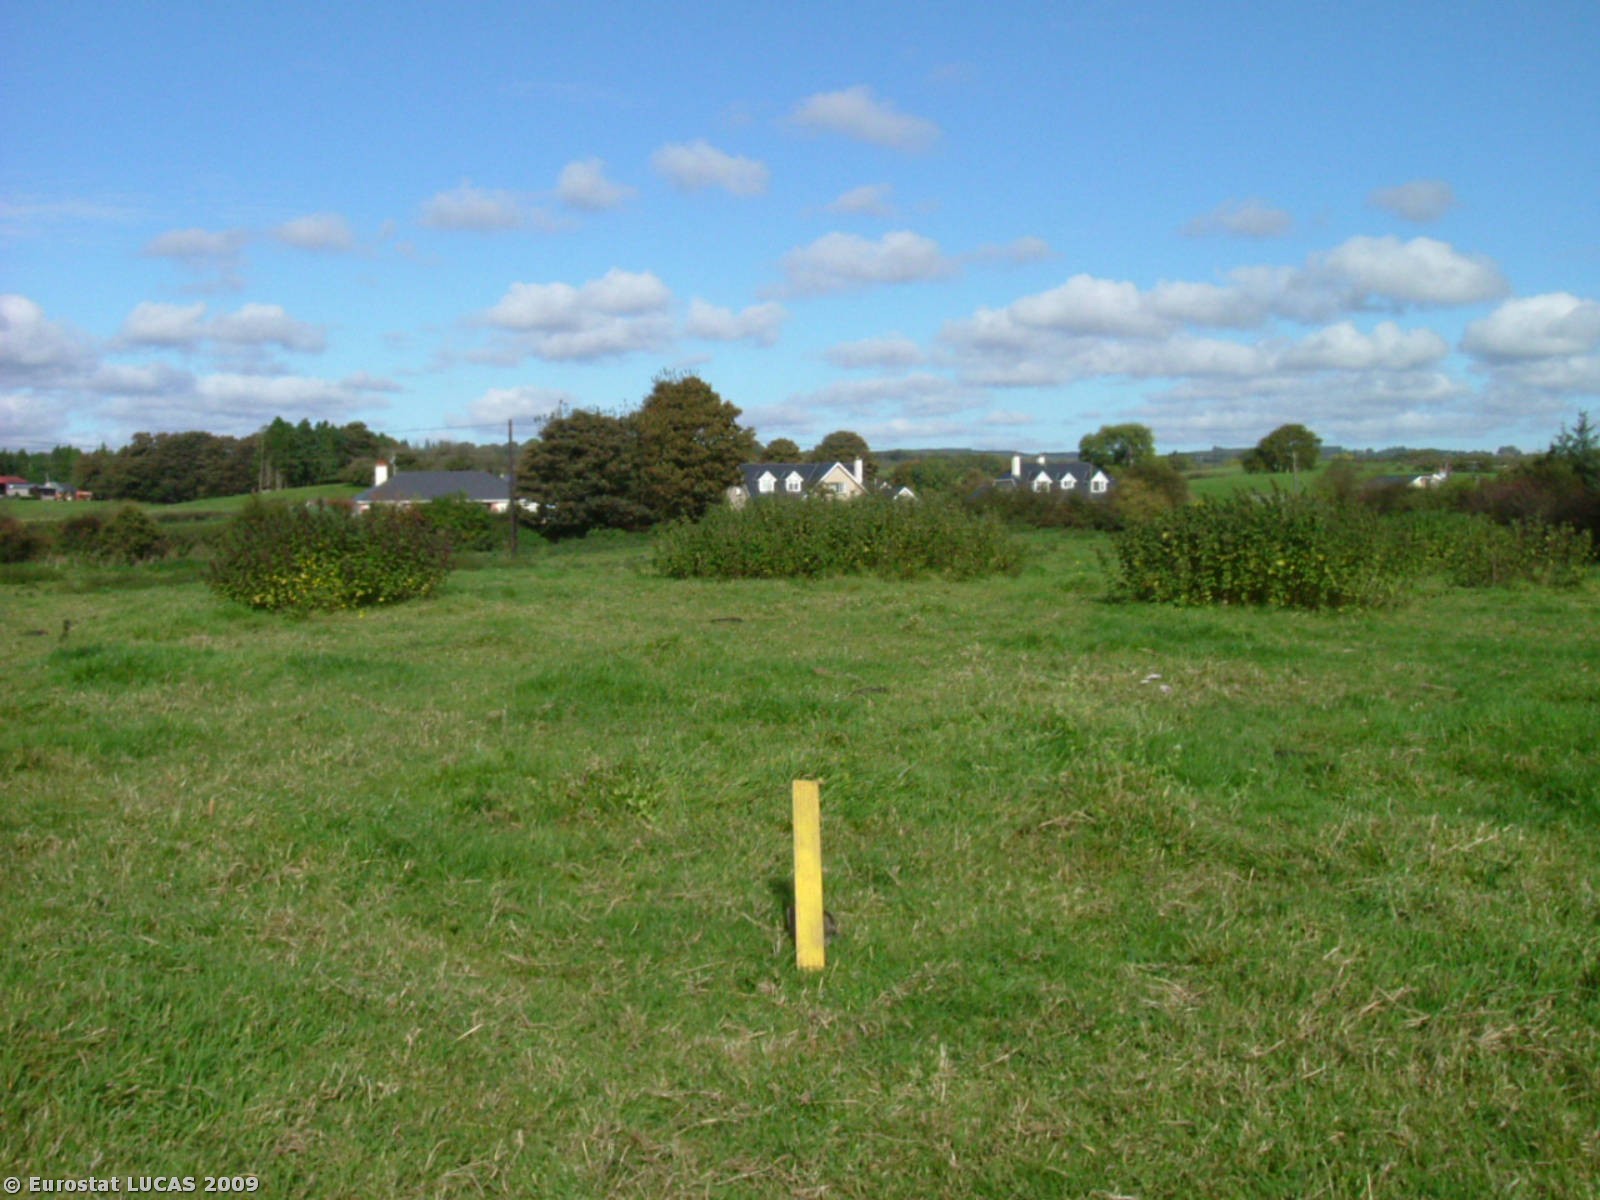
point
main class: Grassland
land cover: Grassland without tree/shrub cover
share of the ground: > 75 %
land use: Agriculture (excluding fallow land and kitchen gardens)
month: October
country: IE
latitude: 52.5558
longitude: -8.1002
